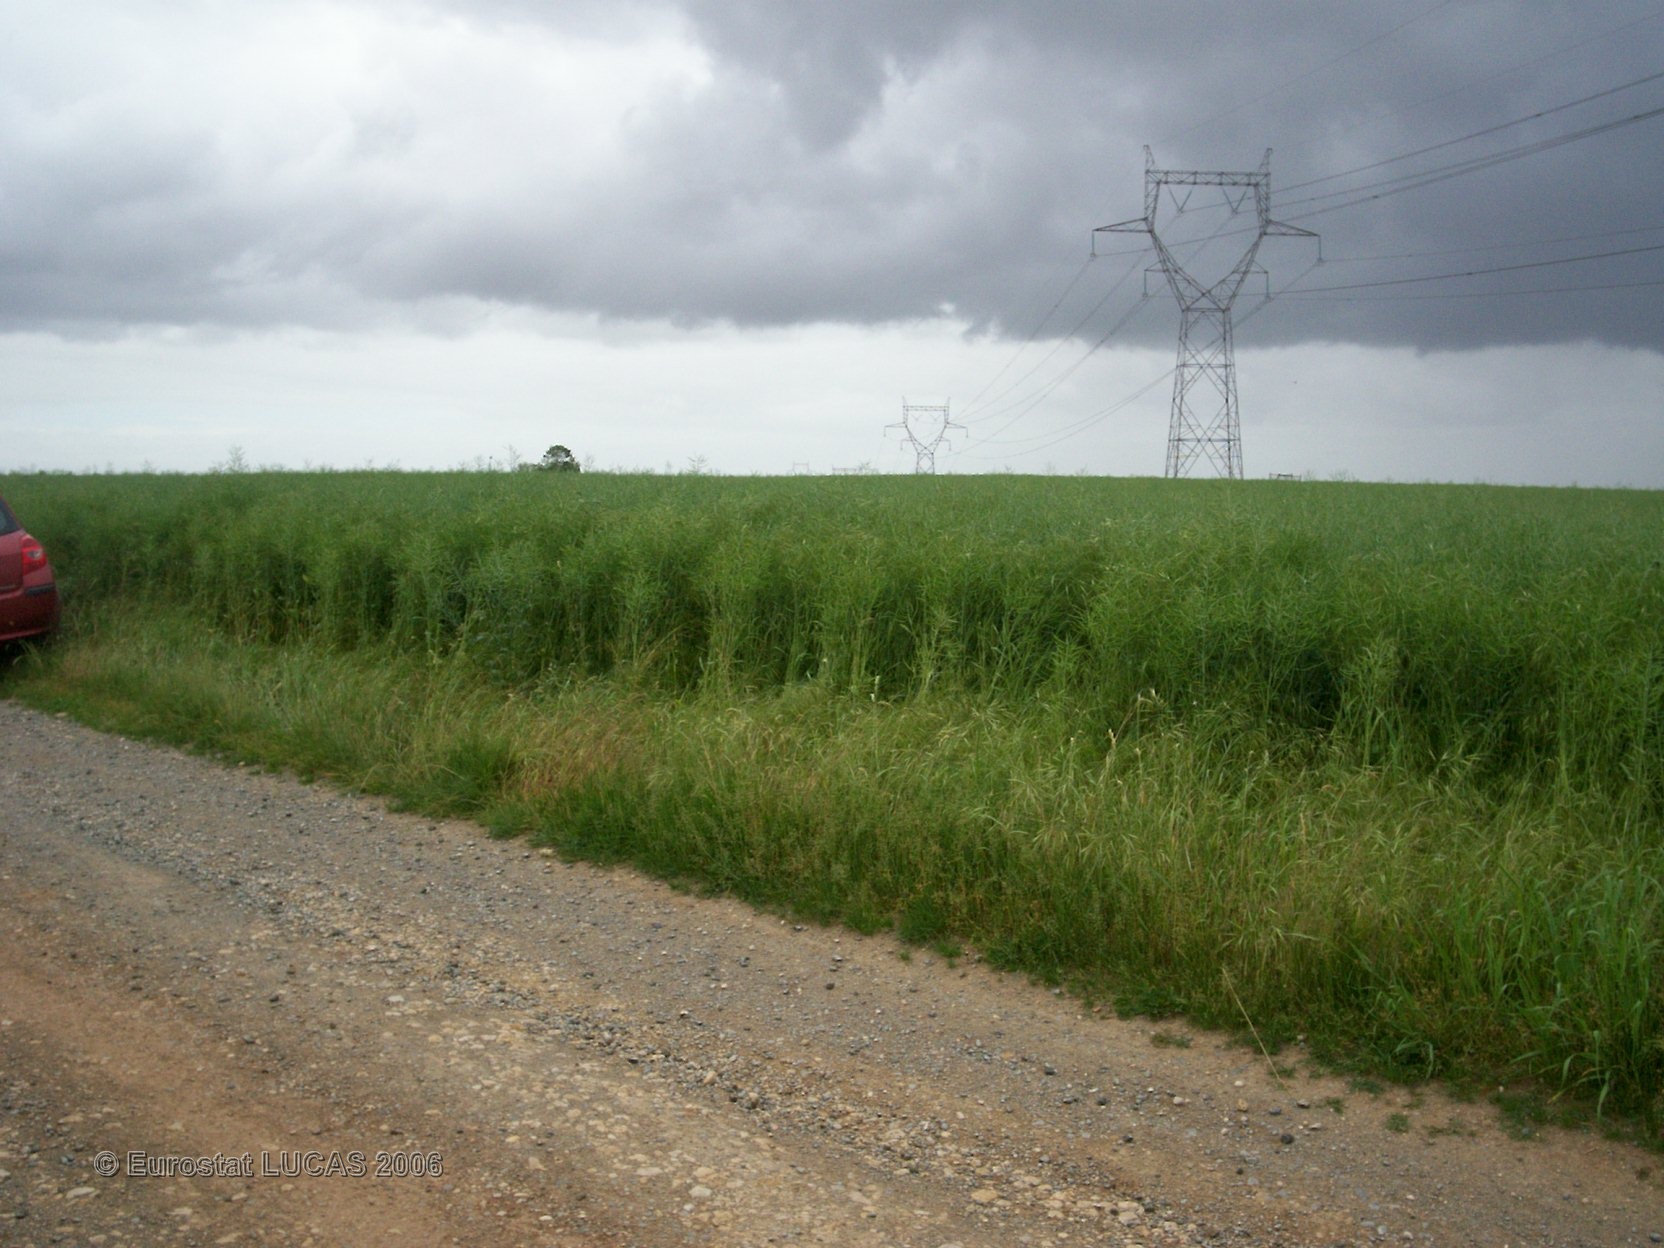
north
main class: Cropland
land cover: Rape and turnip rape
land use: Agriculture (excluding fallow land and kitchen gardens)
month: May
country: FR
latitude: 46.3629
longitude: -0.2788
